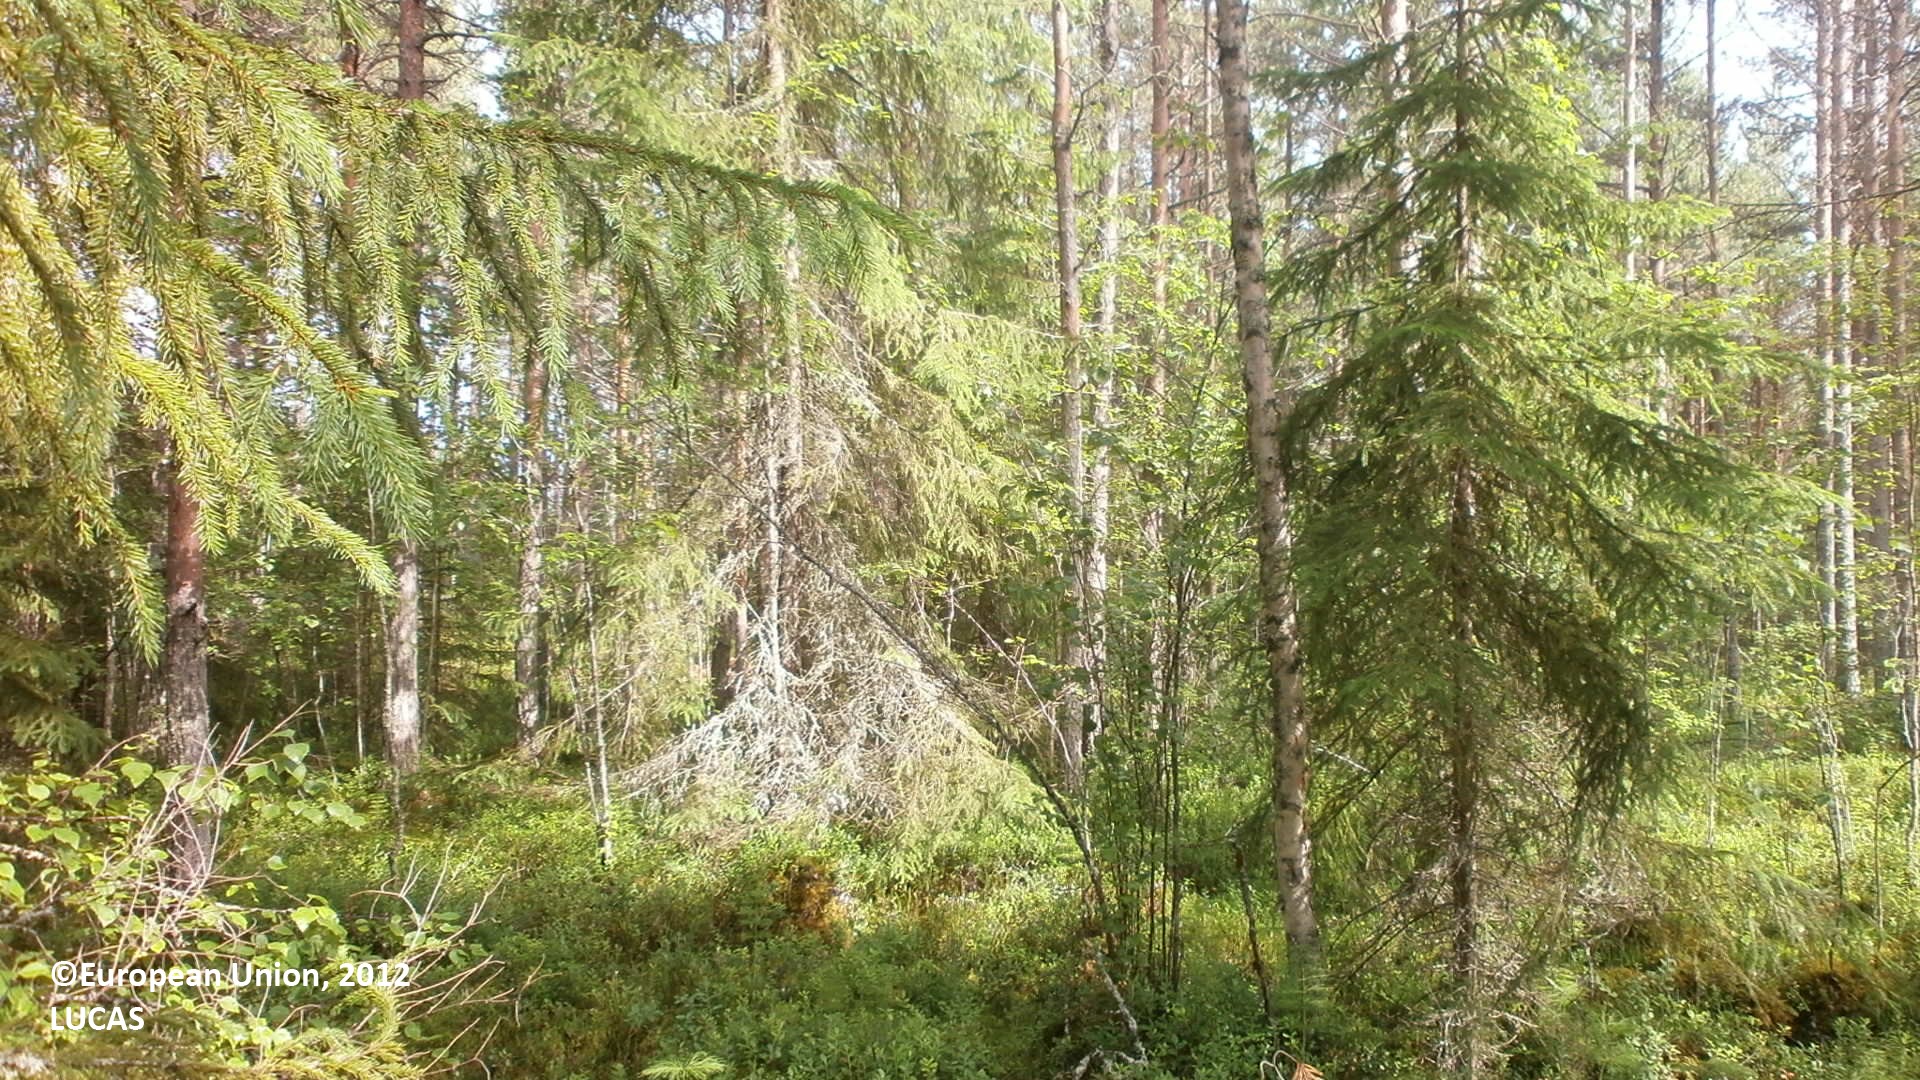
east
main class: Woodland
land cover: Pine dominated coniferous woodland
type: boreal forest
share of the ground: 50 - 75 %
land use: Forestry
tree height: > 5 m
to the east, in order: Pine dominated coniferous woodland; Shruby margins; Tracks; Shruby margins; Ditches and canals; Pine dominated mixed woodland; Ditches and canals; Broadleaved woodland; Spontaneously vegetated surfaces; Broadleaved woodland; Ditches and canals; Broadleaved woodland; Ditches and canals; Shruby margins; Temporary grasslands
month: July
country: FI
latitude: 64.4953
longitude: 24.3665
